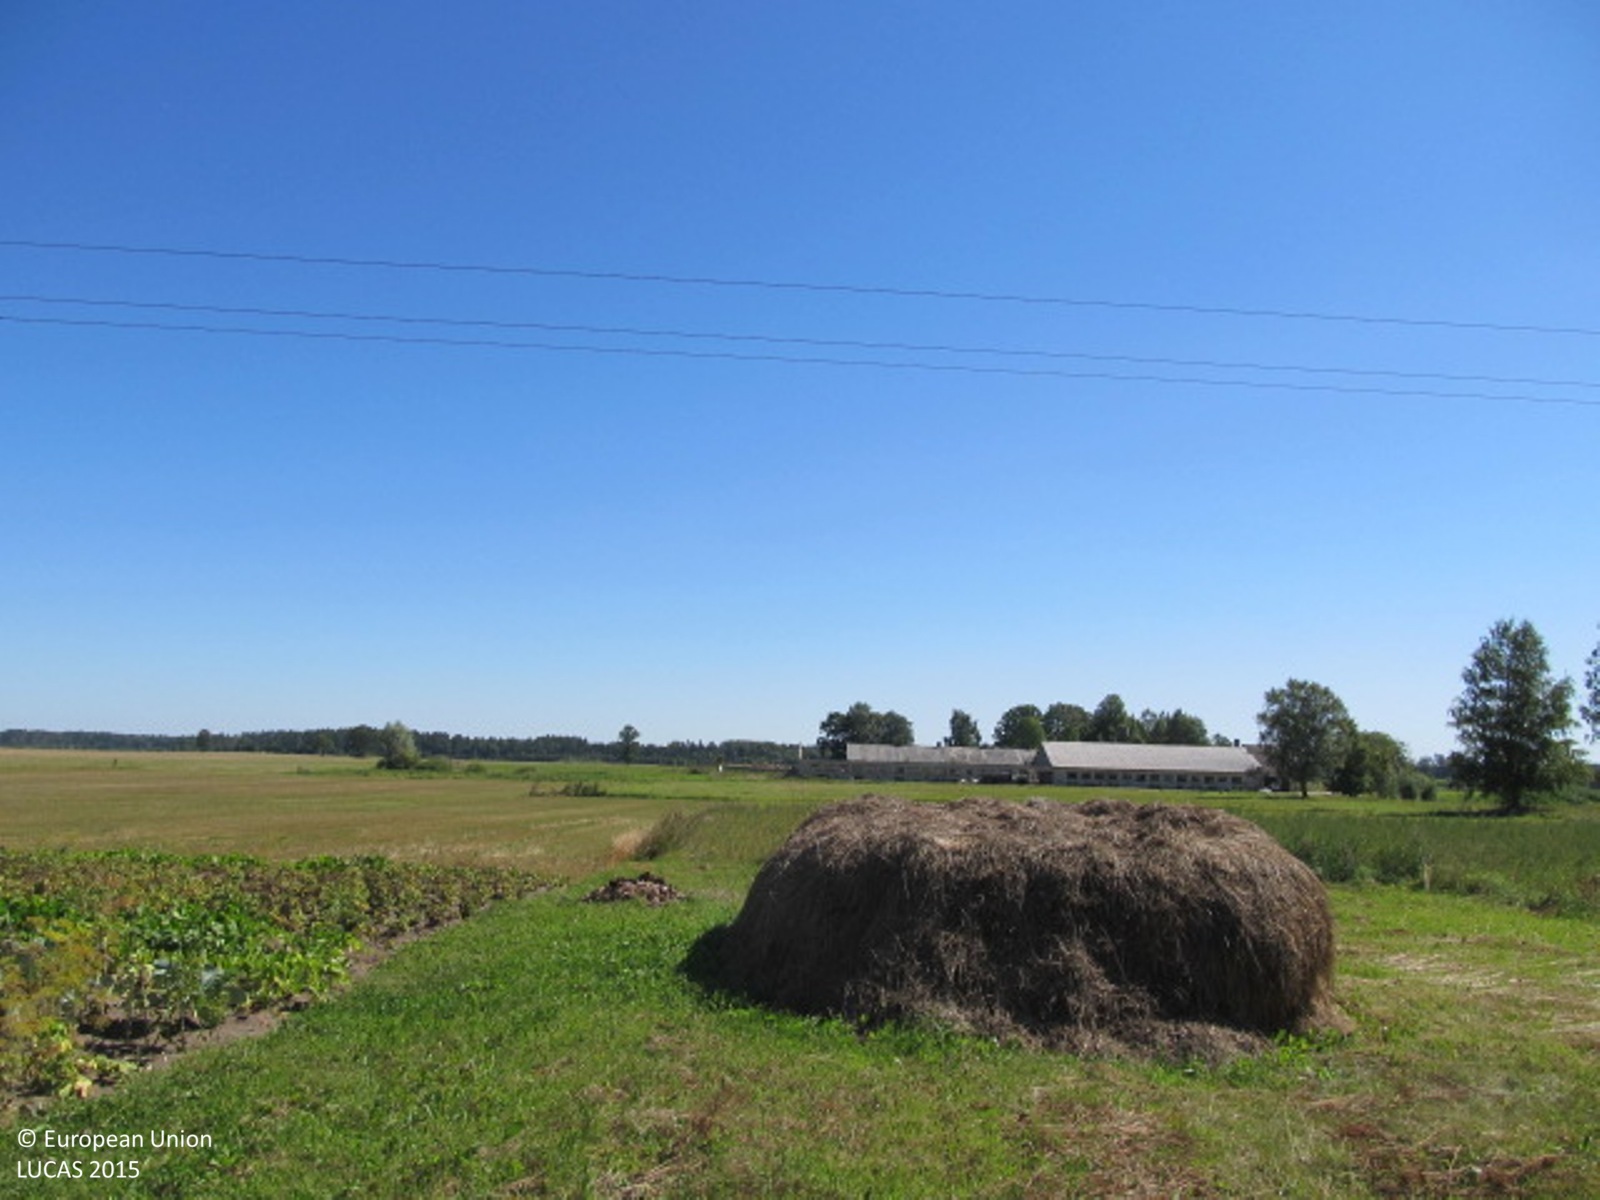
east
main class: Grassland
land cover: Grassland without tree/shrub cover
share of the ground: > 75 %
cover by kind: herbaceous plants 100 %
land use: Agriculture (excluding fallow land and kitchen gardens)
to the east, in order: Grassland without tree/shrub cover; Electric lines; Grassland without tree/shrub cover; Spontaneously vegetated surfaces; Oats; Grassland without tree/shrub cover; Tracks; Grassland without tree/shrub cover
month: August
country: LT
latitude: 56.1884
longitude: 22.5471
